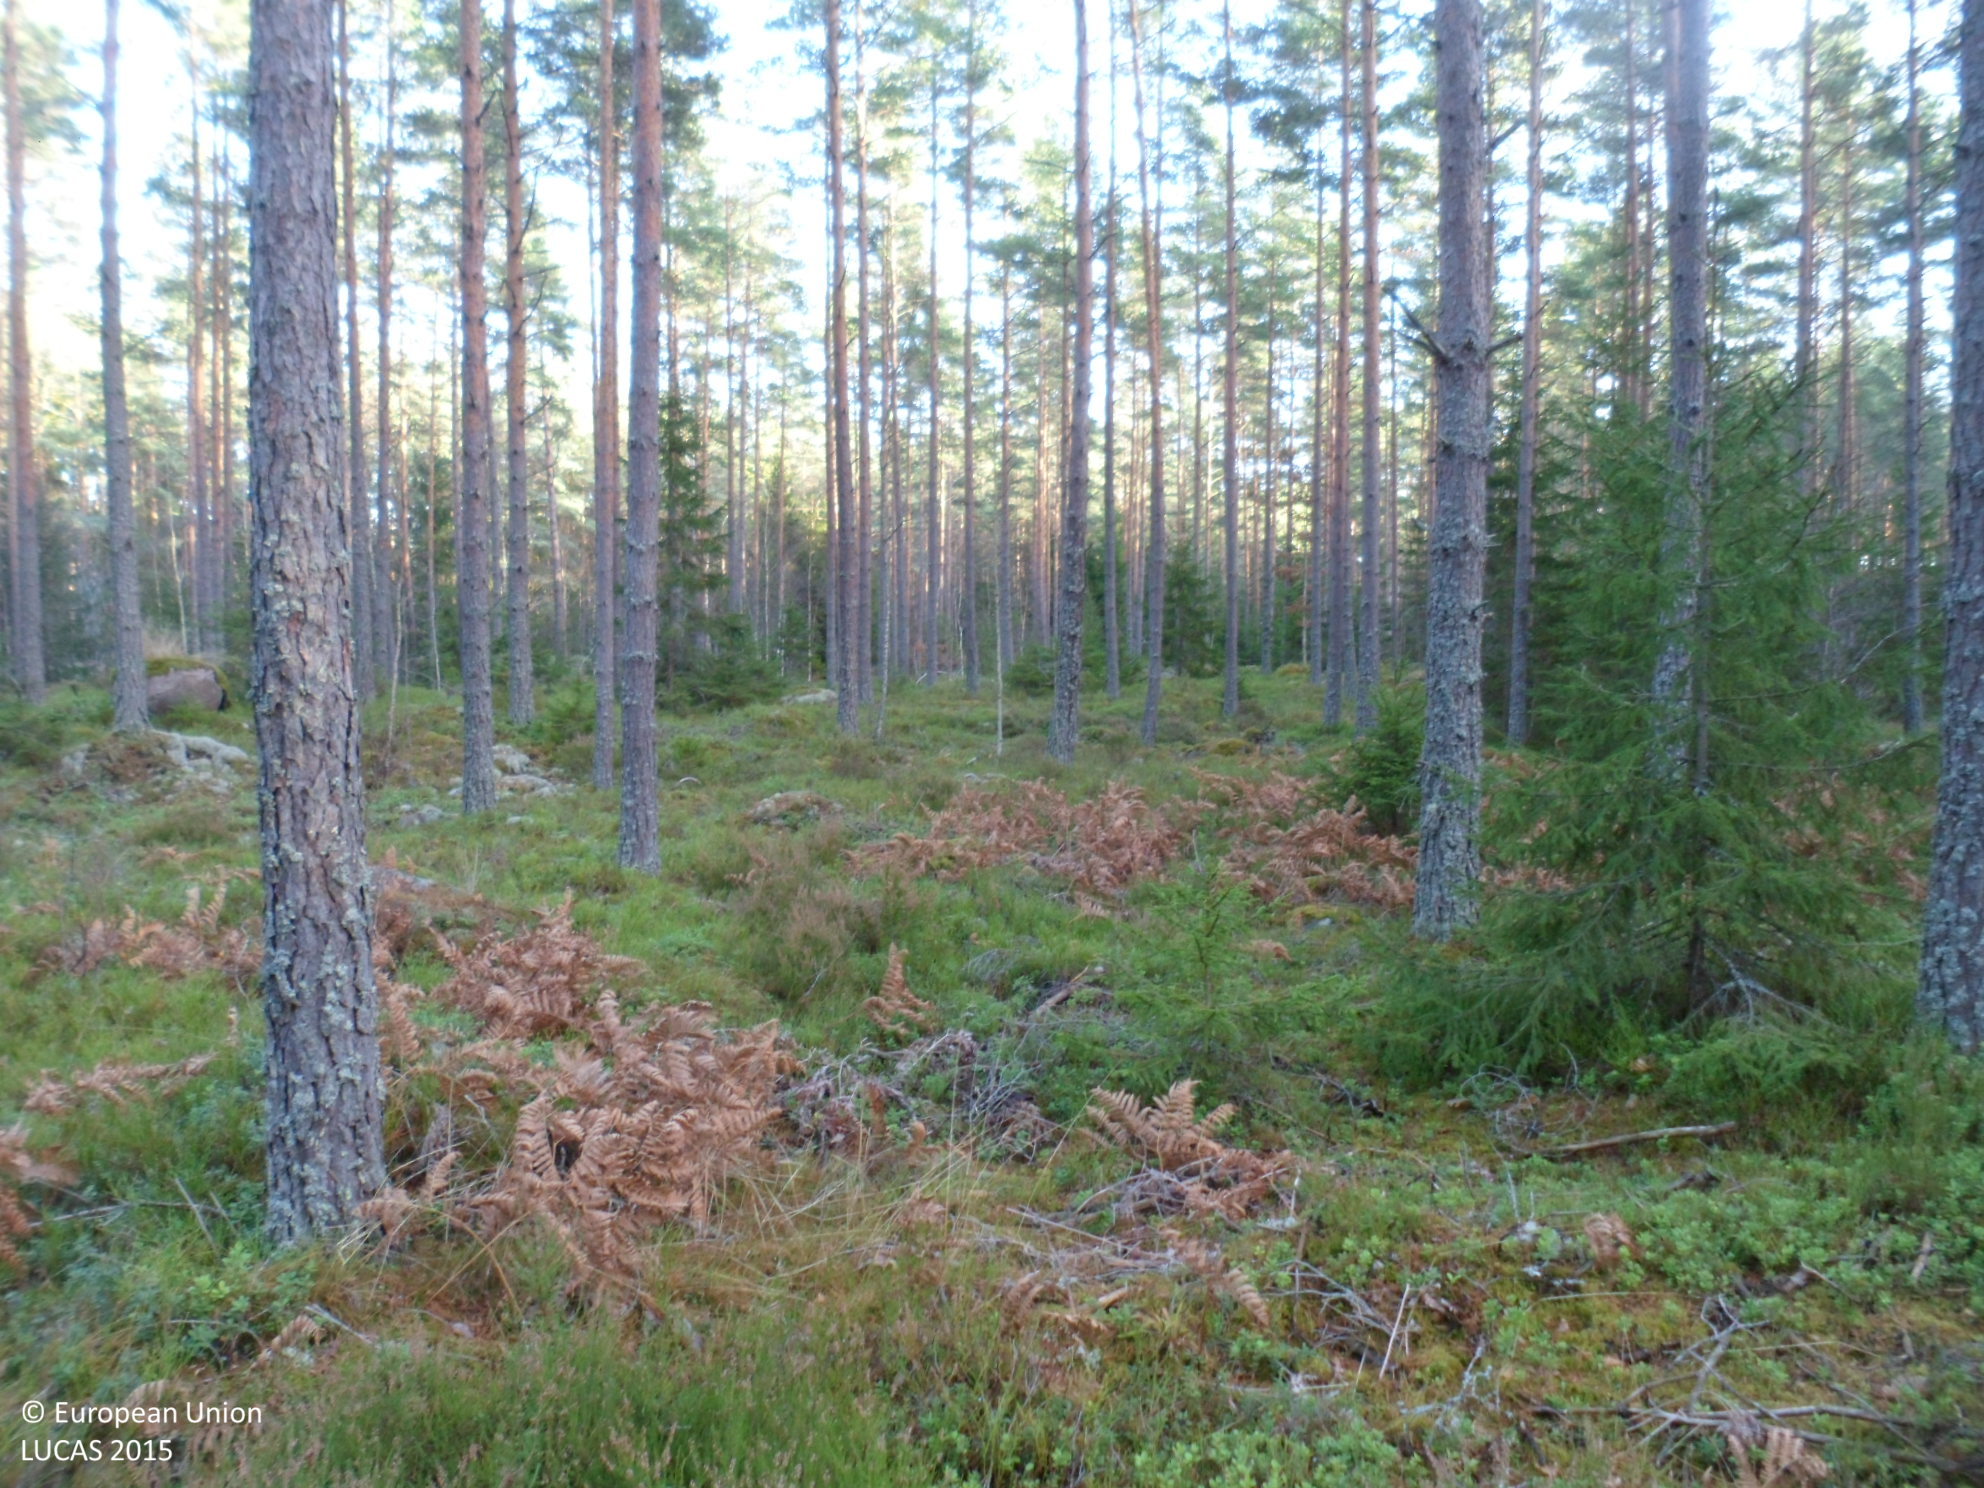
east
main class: Woodland
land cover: Pine dominated coniferous woodland
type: boreal forest
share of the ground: 25 - 50 %
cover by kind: coniferous forest trees 50 %, shrubs 25 %, lichens and mosses 25 %
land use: Forestry
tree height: > 5 m
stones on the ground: 25 - 50 %
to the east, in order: Pine dominated coniferous woodland; Grass margins; Paved roads, cycling and walking lanes; Grass margins; Pine dominated coniferous woodland; Spruce dominated coniferous woodland; Tracks; Spruce dominated coniferous woodland; Tracks; Spruce dominated coniferous woodland
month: November
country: SE
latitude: 56.8611
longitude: 15.9531
